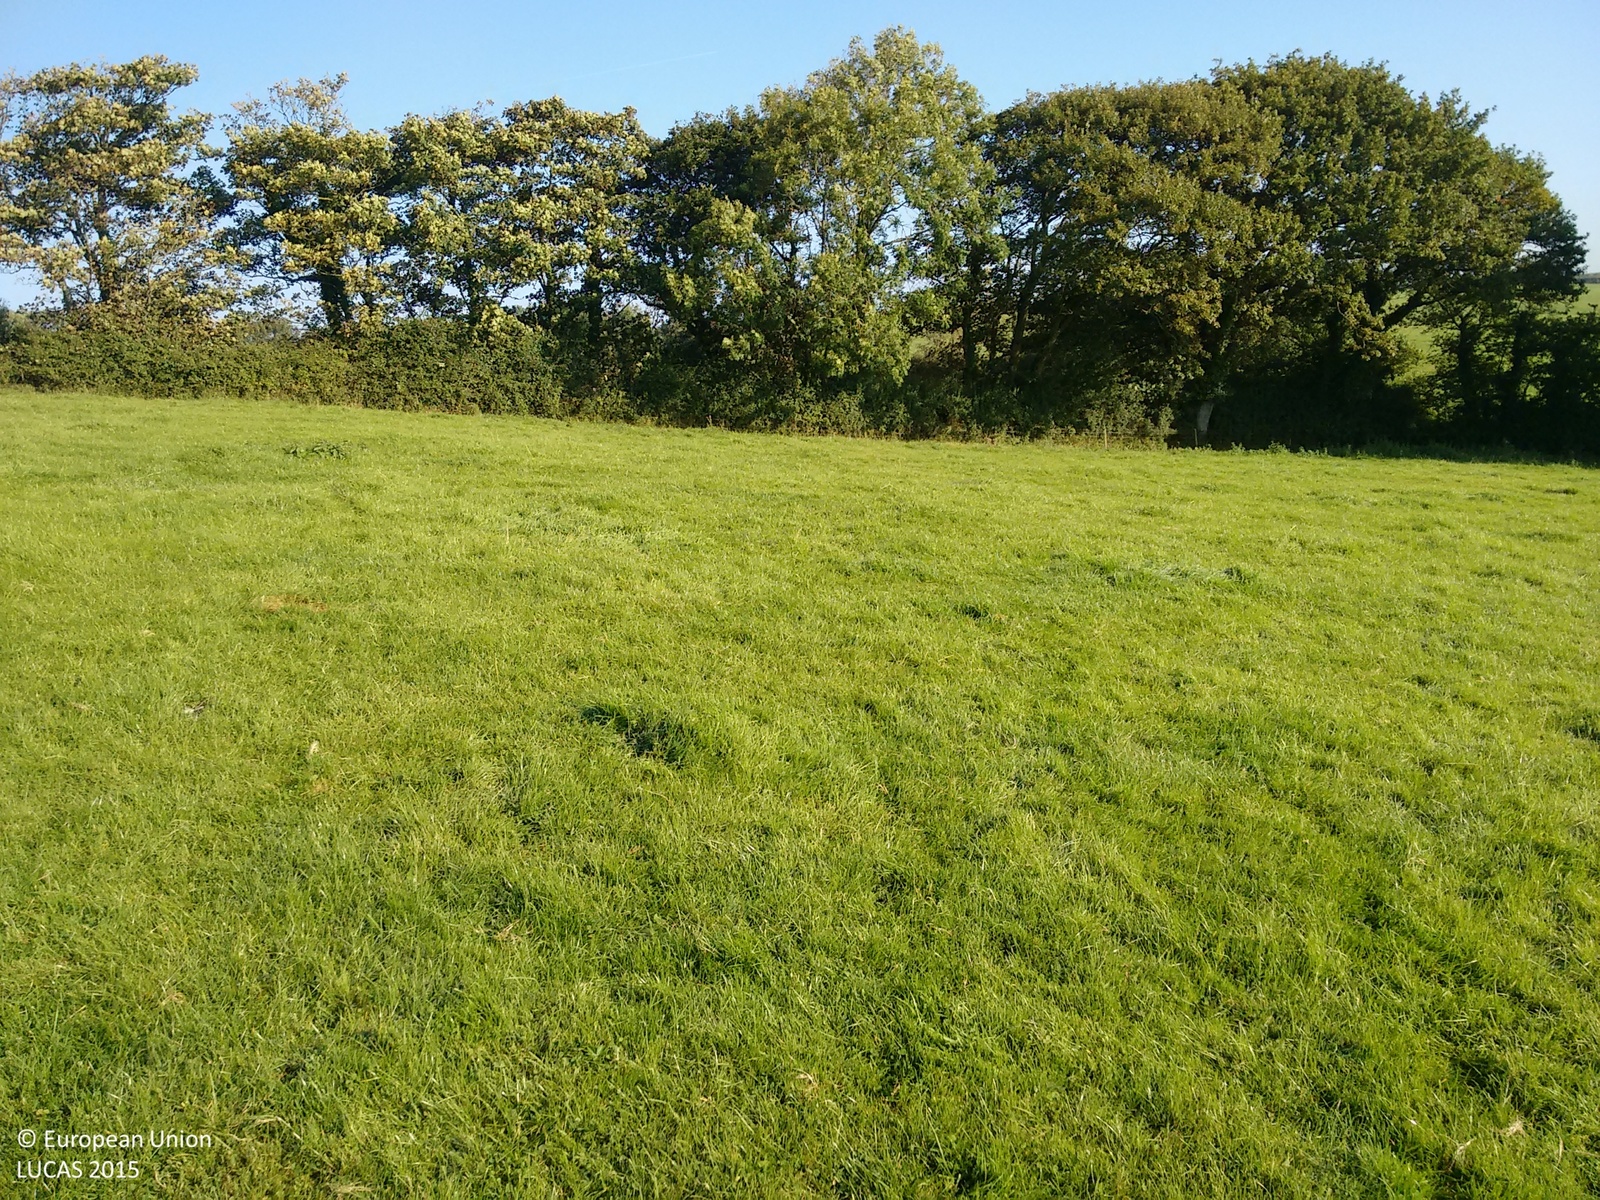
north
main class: Grassland
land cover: Grassland without tree/shrub cover
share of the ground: > 75 %
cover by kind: herbaceous plants 100 %
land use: Agriculture (excluding fallow land and kitchen gardens)
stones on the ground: < 10 %
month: September
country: GB
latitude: 50.8034
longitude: -4.5075
